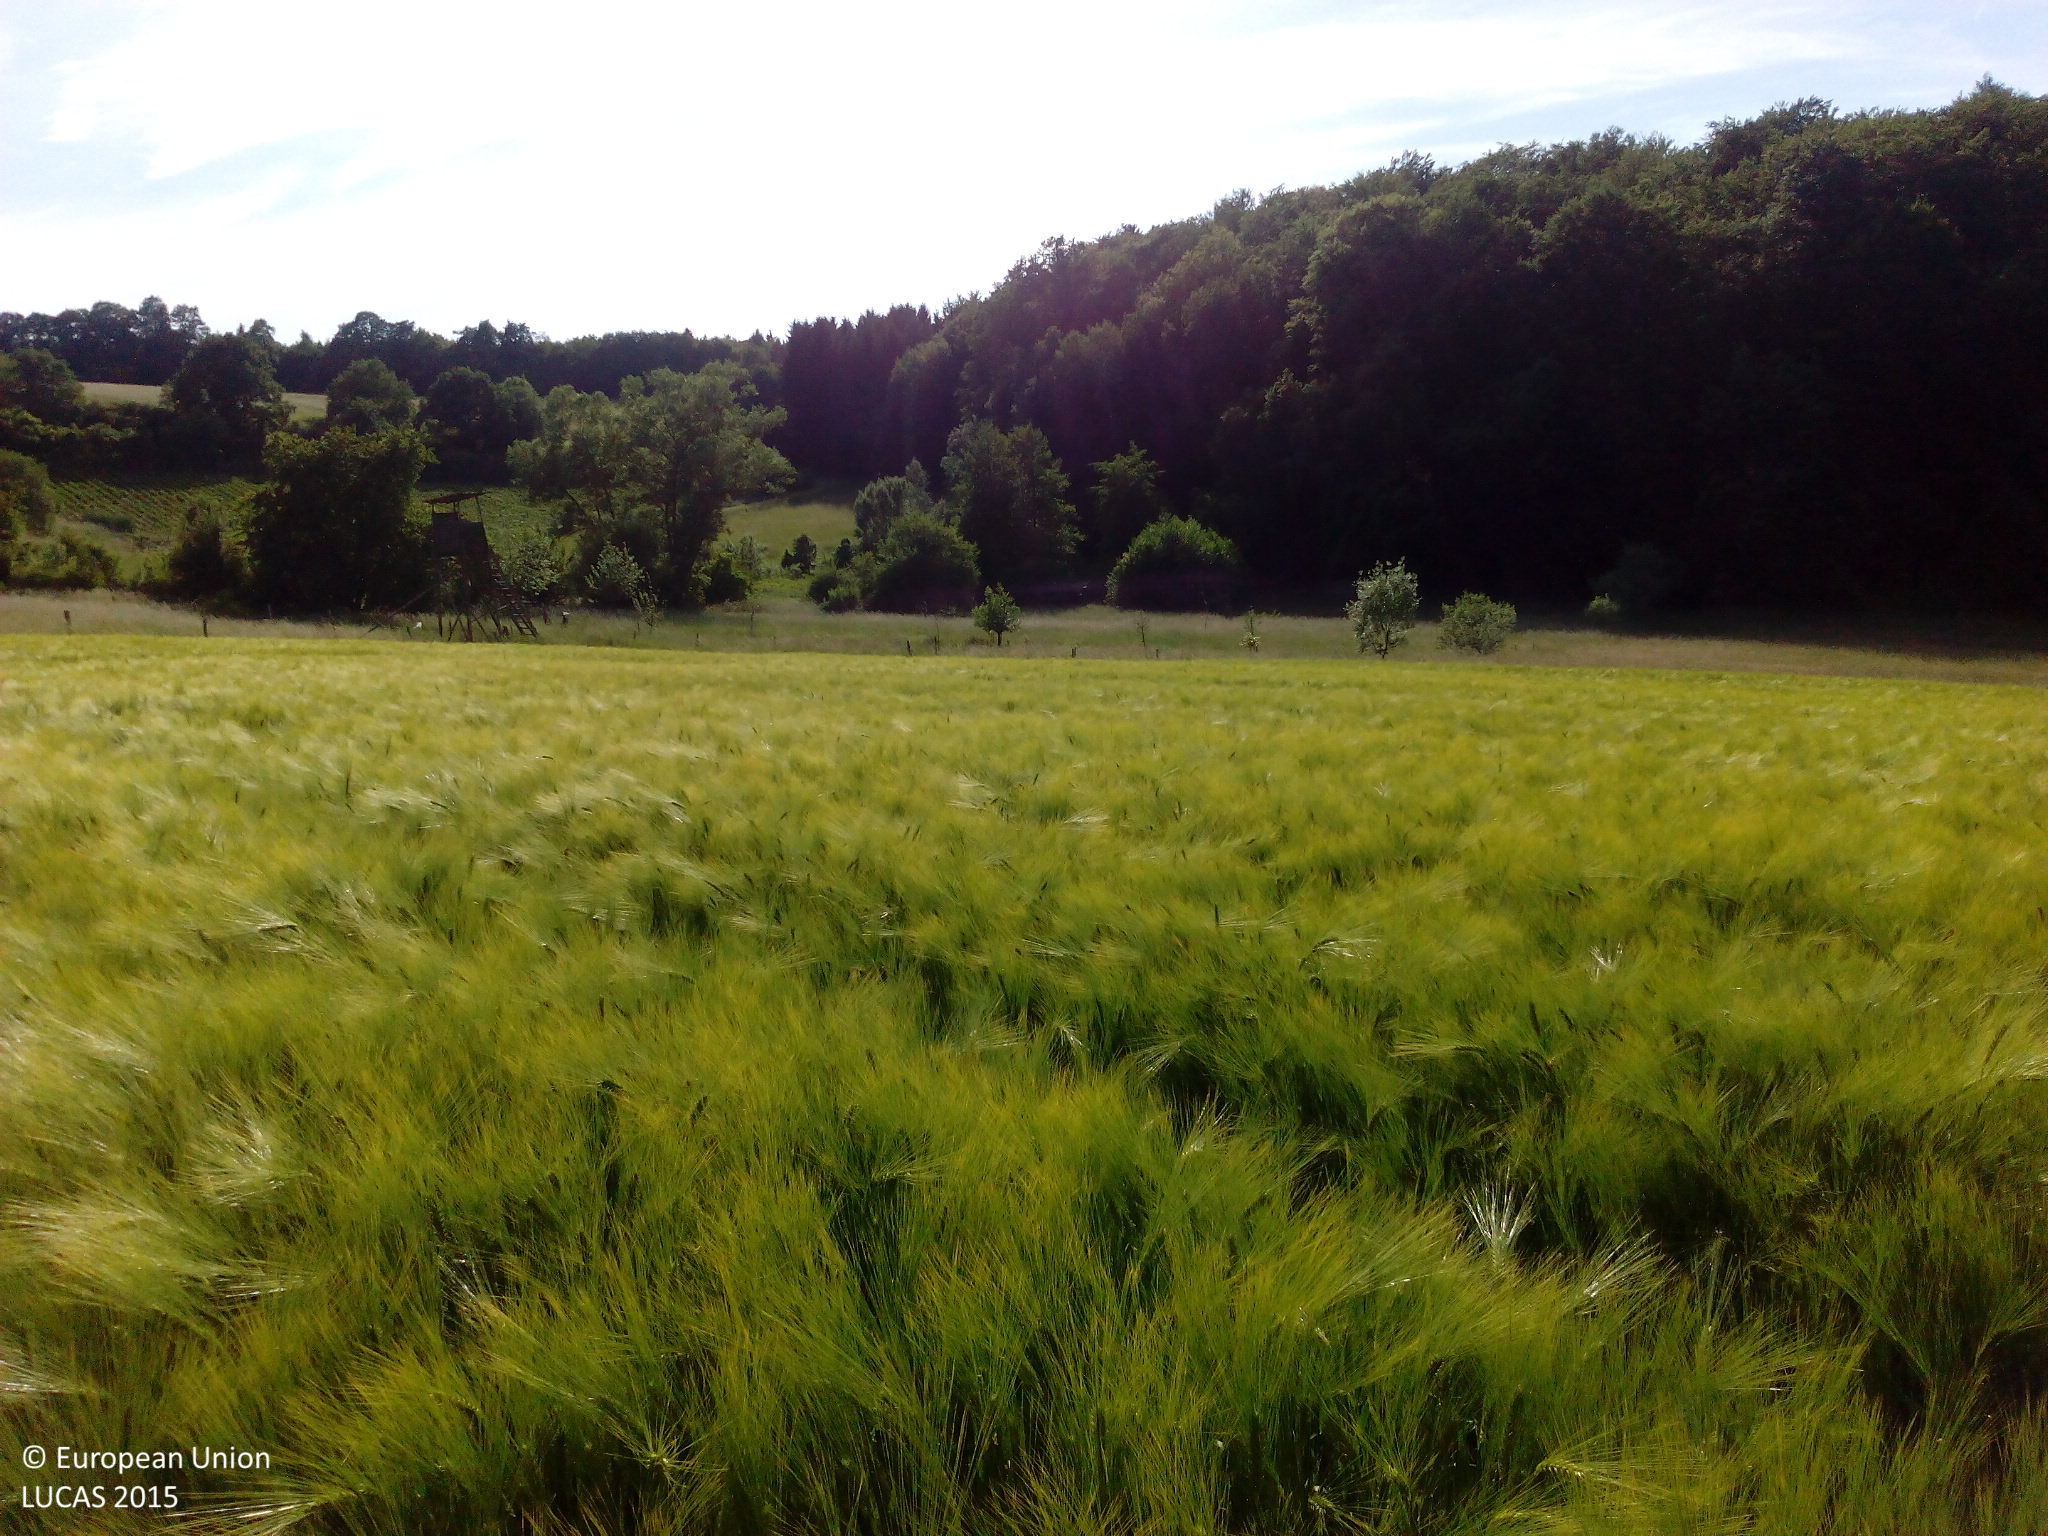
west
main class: Cropland
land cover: Barley
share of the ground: > 75 %
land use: Agriculture (excluding fallow land and kitchen gardens)
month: June
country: DE
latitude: 50.1686
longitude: 8.1104
